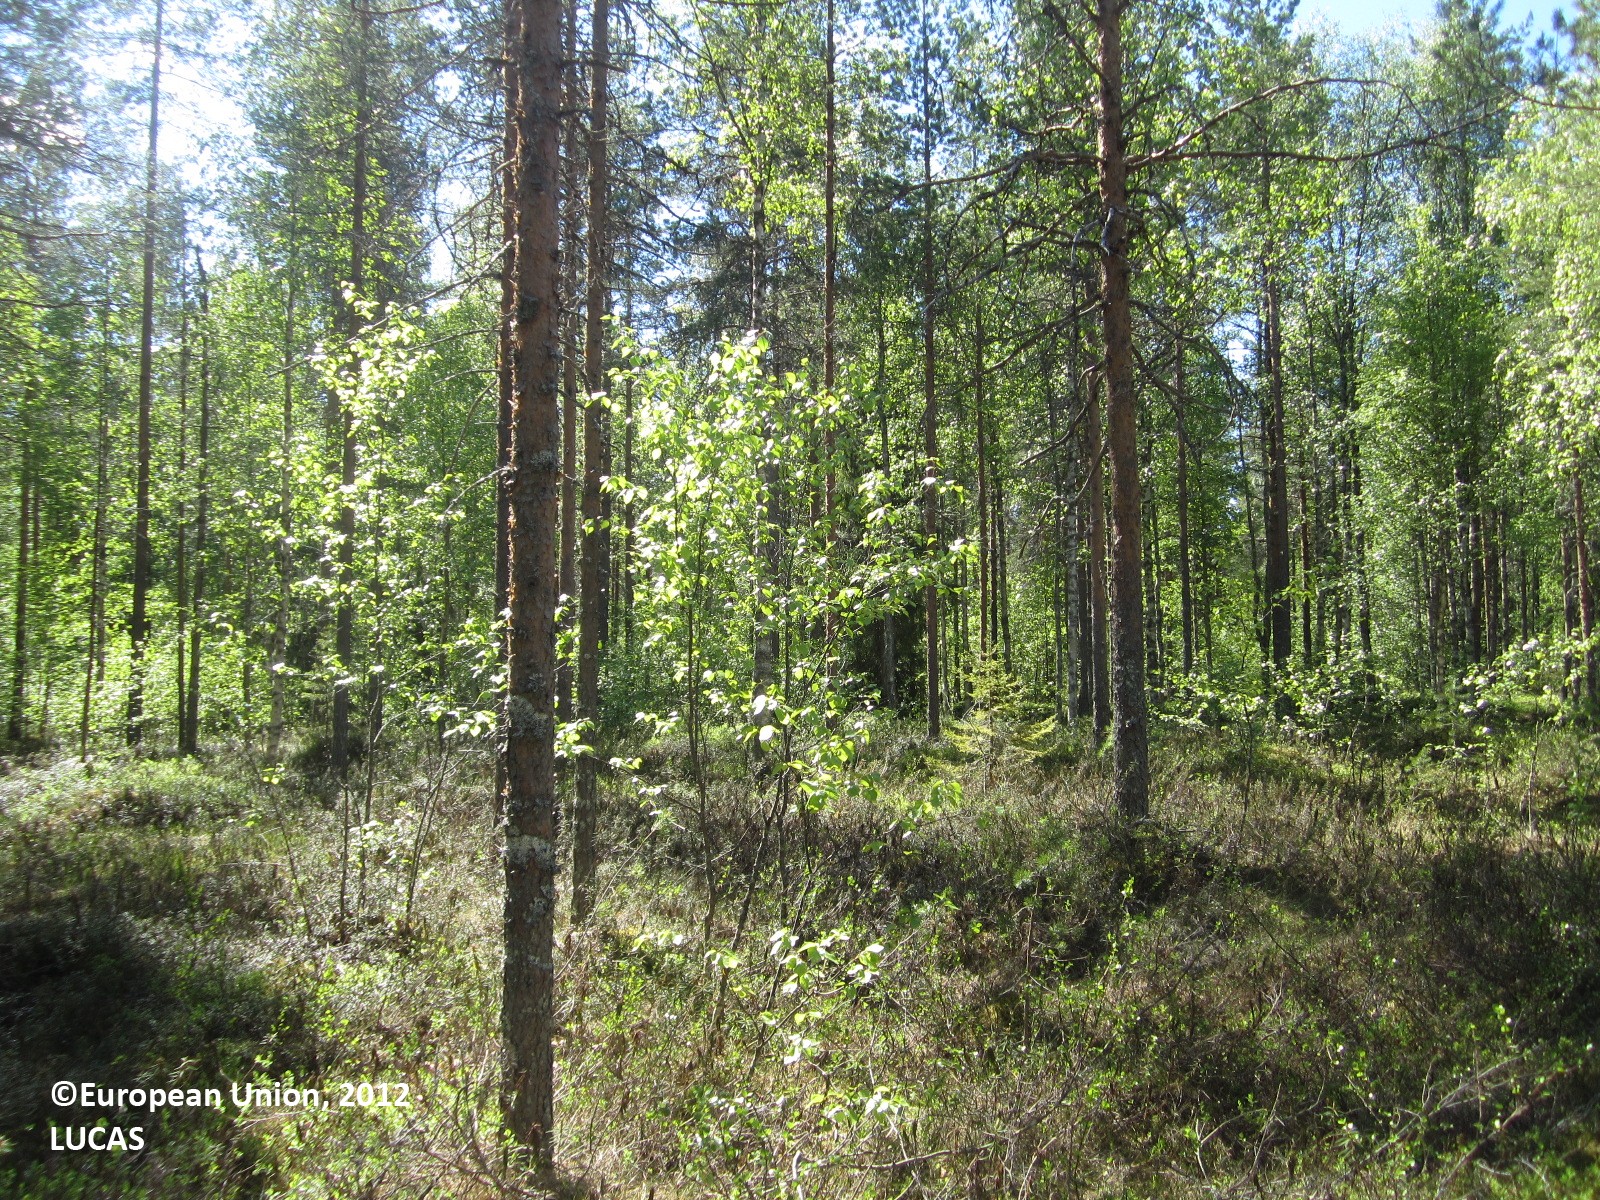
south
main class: Woodland
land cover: Pine dominated mixed woodland
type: boreal forest
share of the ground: 50 - 75 %
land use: Forestry
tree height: > 5 m
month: June
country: FI
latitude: 64.9034
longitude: 28.7967
